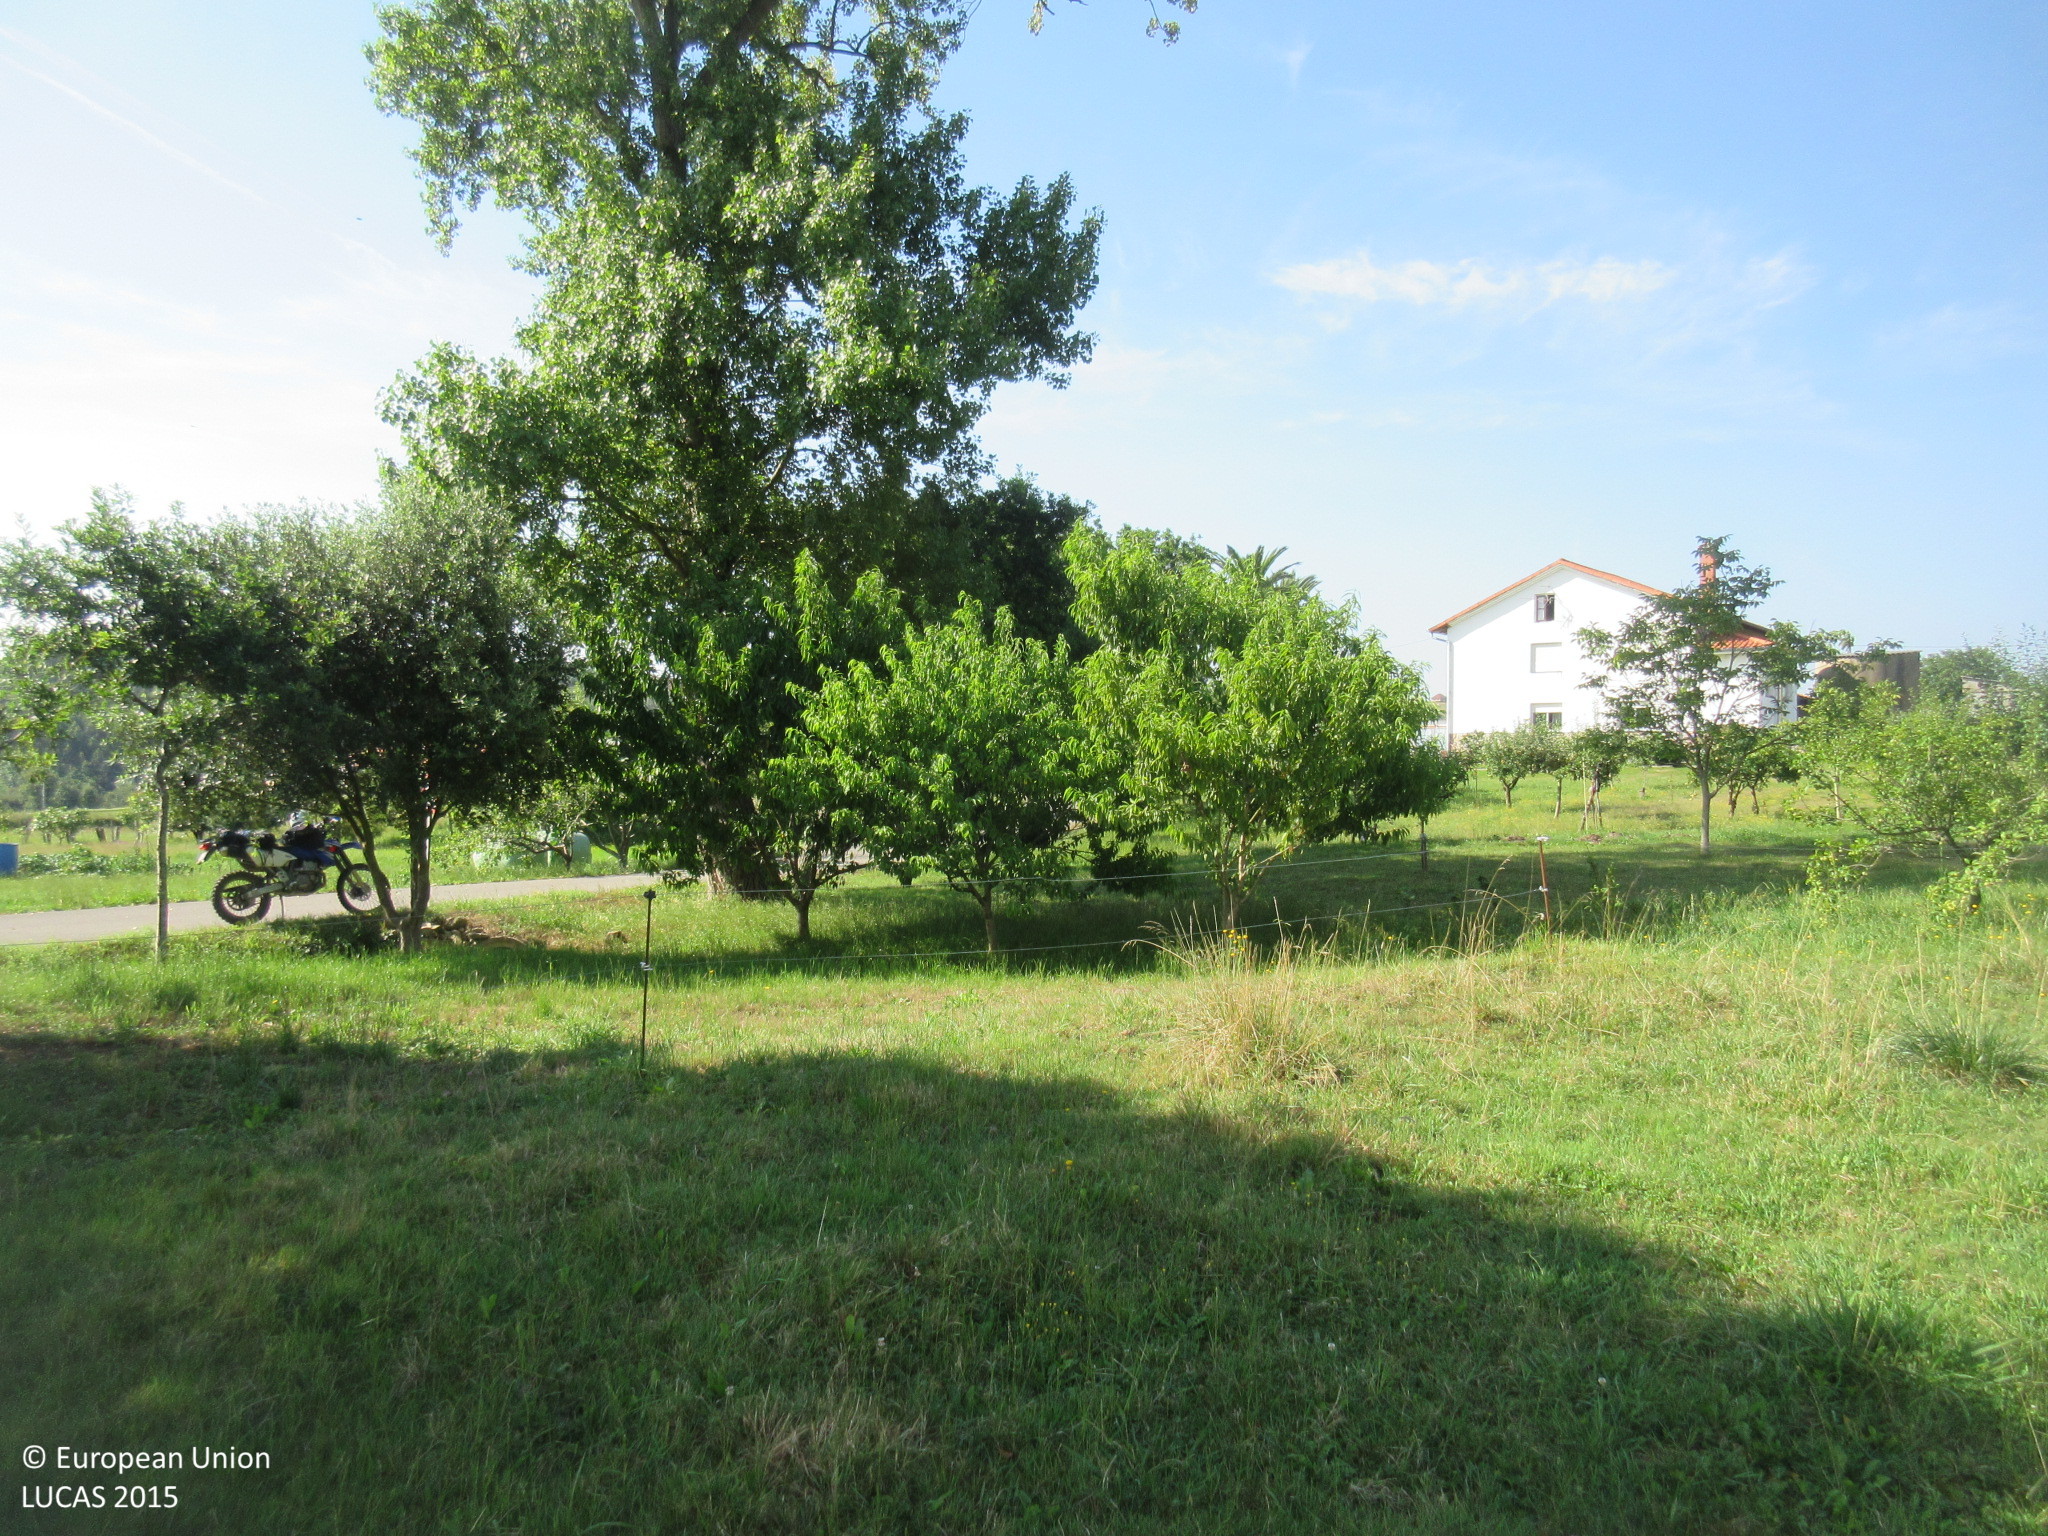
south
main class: Grassland
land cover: Grassland without tree/shrub cover
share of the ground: > 75 %
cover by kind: herbaceous plants 100 %
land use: Agriculture (excluding fallow land and kitchen gardens)
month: July
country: ES
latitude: 43.4183
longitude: -3.9709
